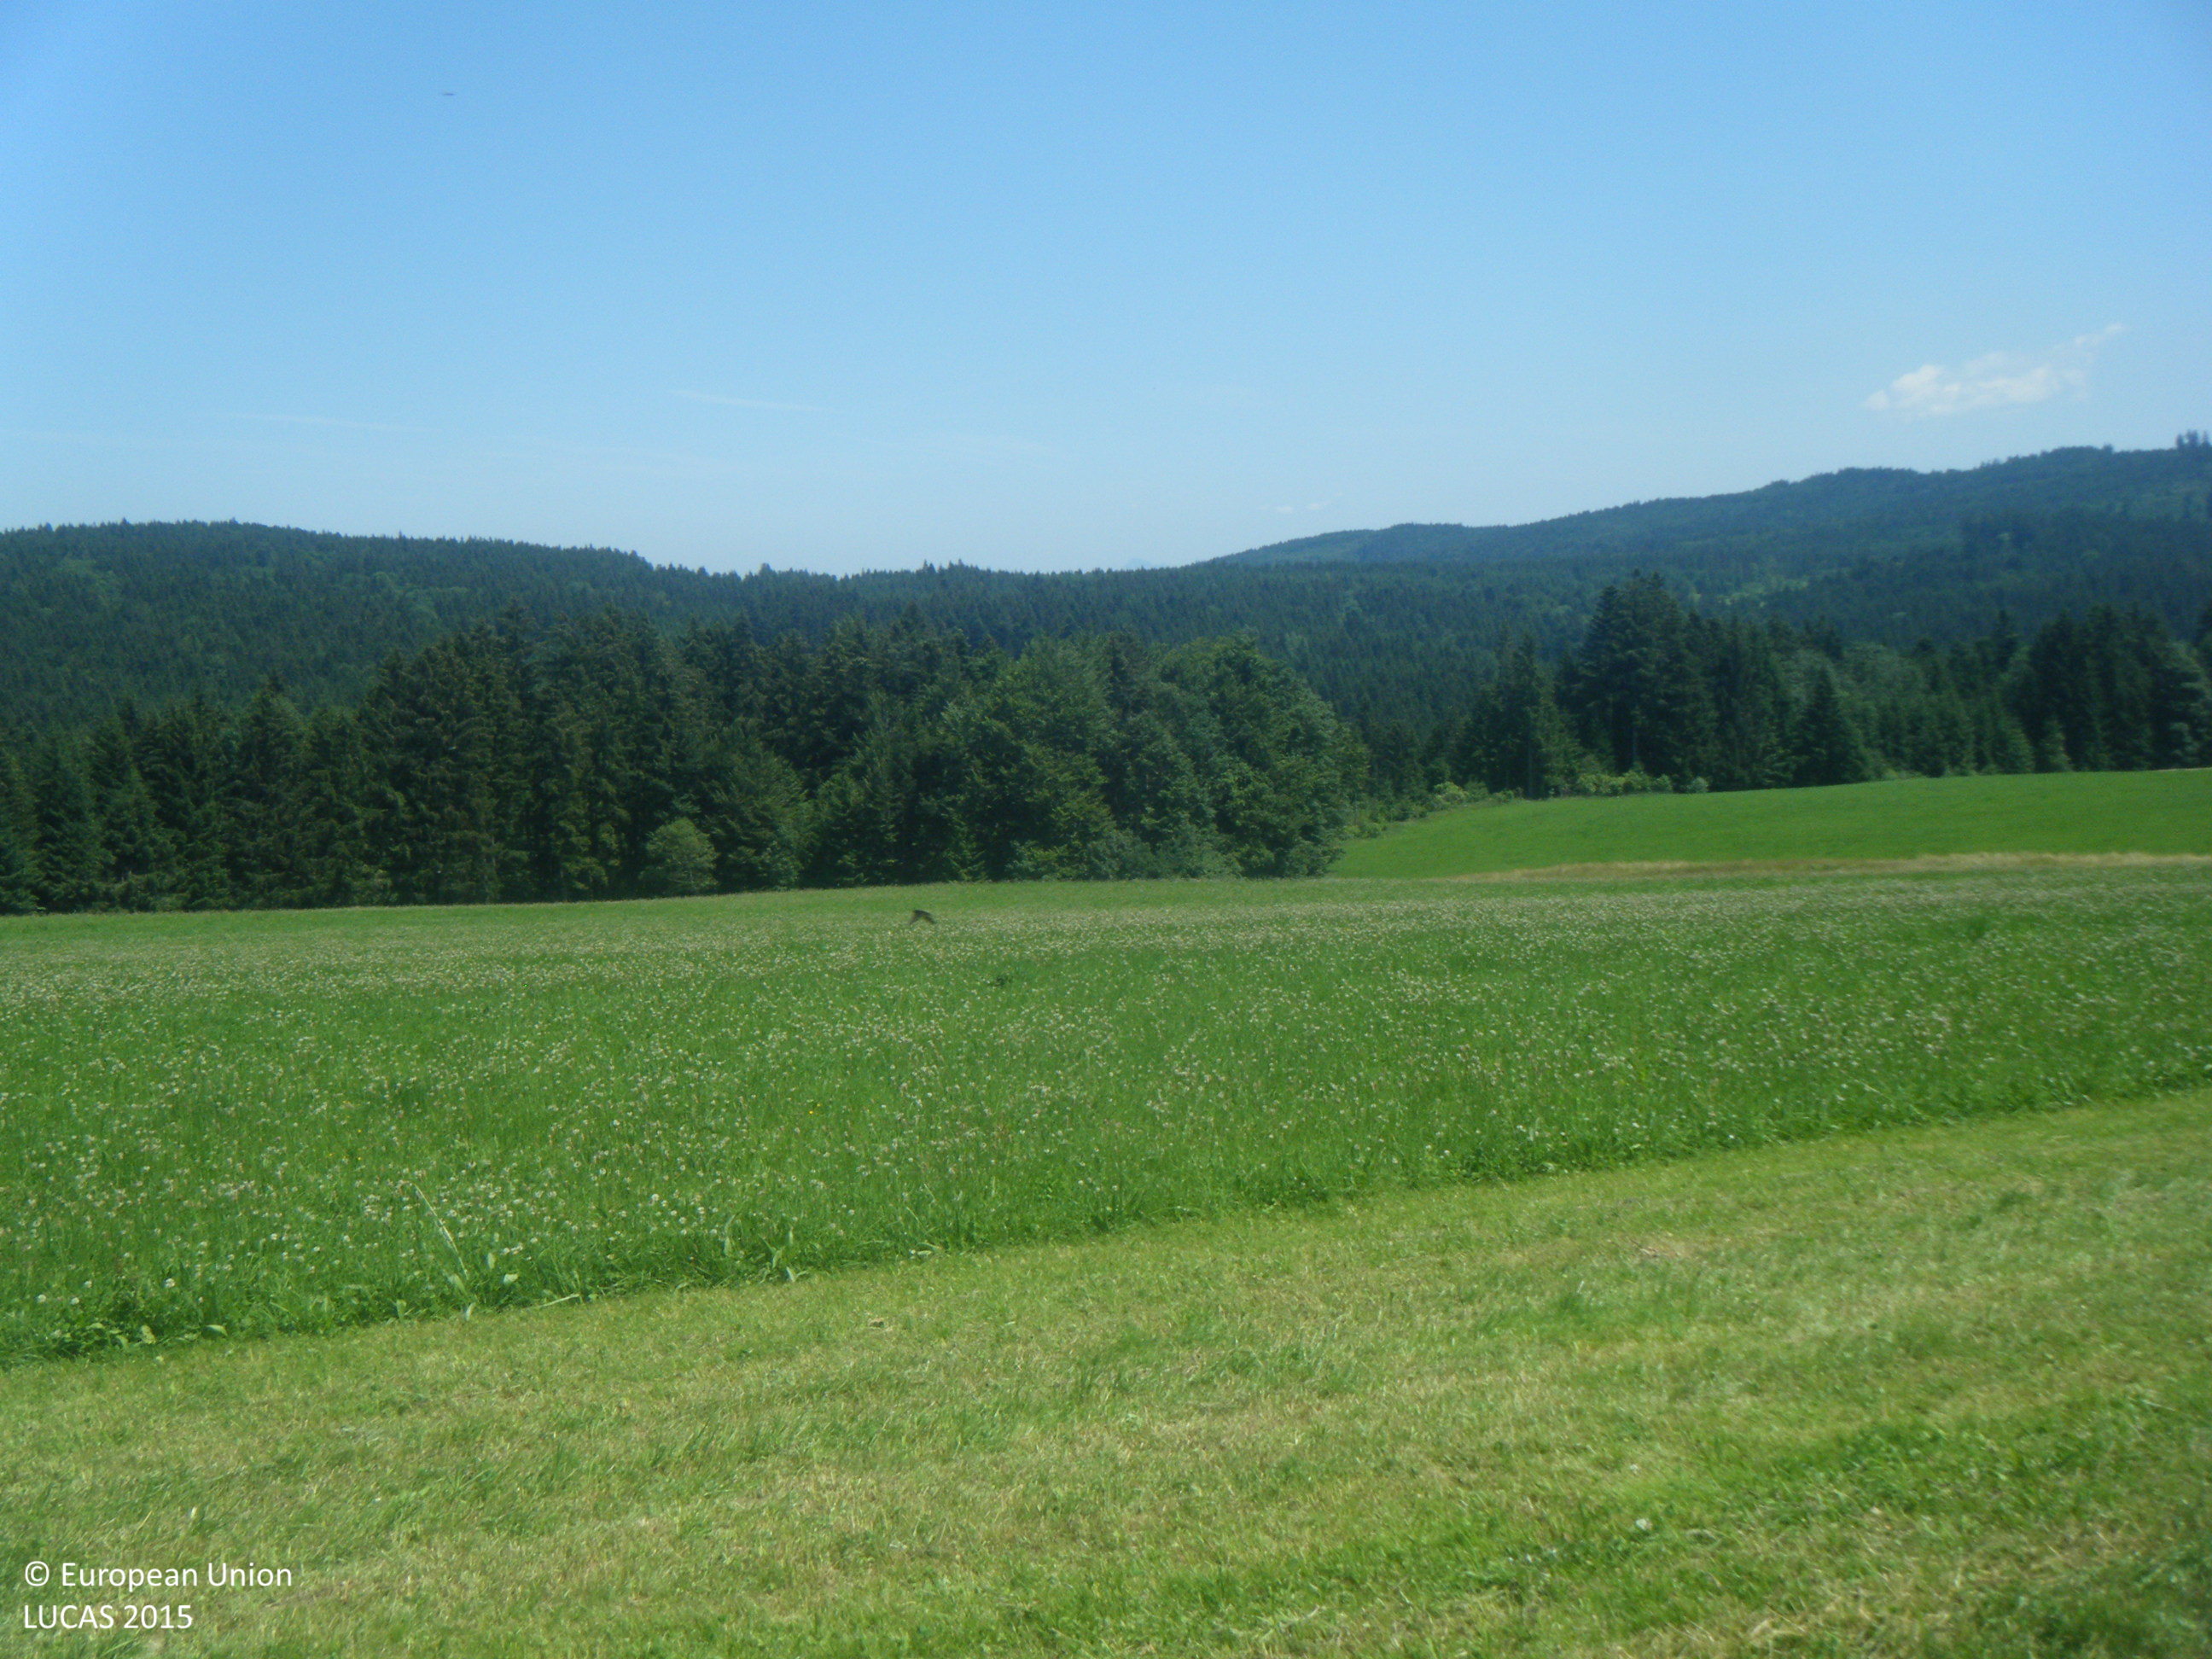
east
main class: Grassland
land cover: Grassland without tree/shrub cover
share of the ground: > 75 %
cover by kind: herbaceous plants 100 %
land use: Agriculture (excluding fallow land and kitchen gardens)
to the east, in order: Grassland without tree/shrub cover; Ditches and canals; Grassland without tree/shrub cover; Broadleaved woodland; Other mixed woodland; Rivers and streams; Other mixed woodland; Rivers and streams; Other mixed woodland
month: July
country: AT
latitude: 47.8843
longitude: 13.3554
